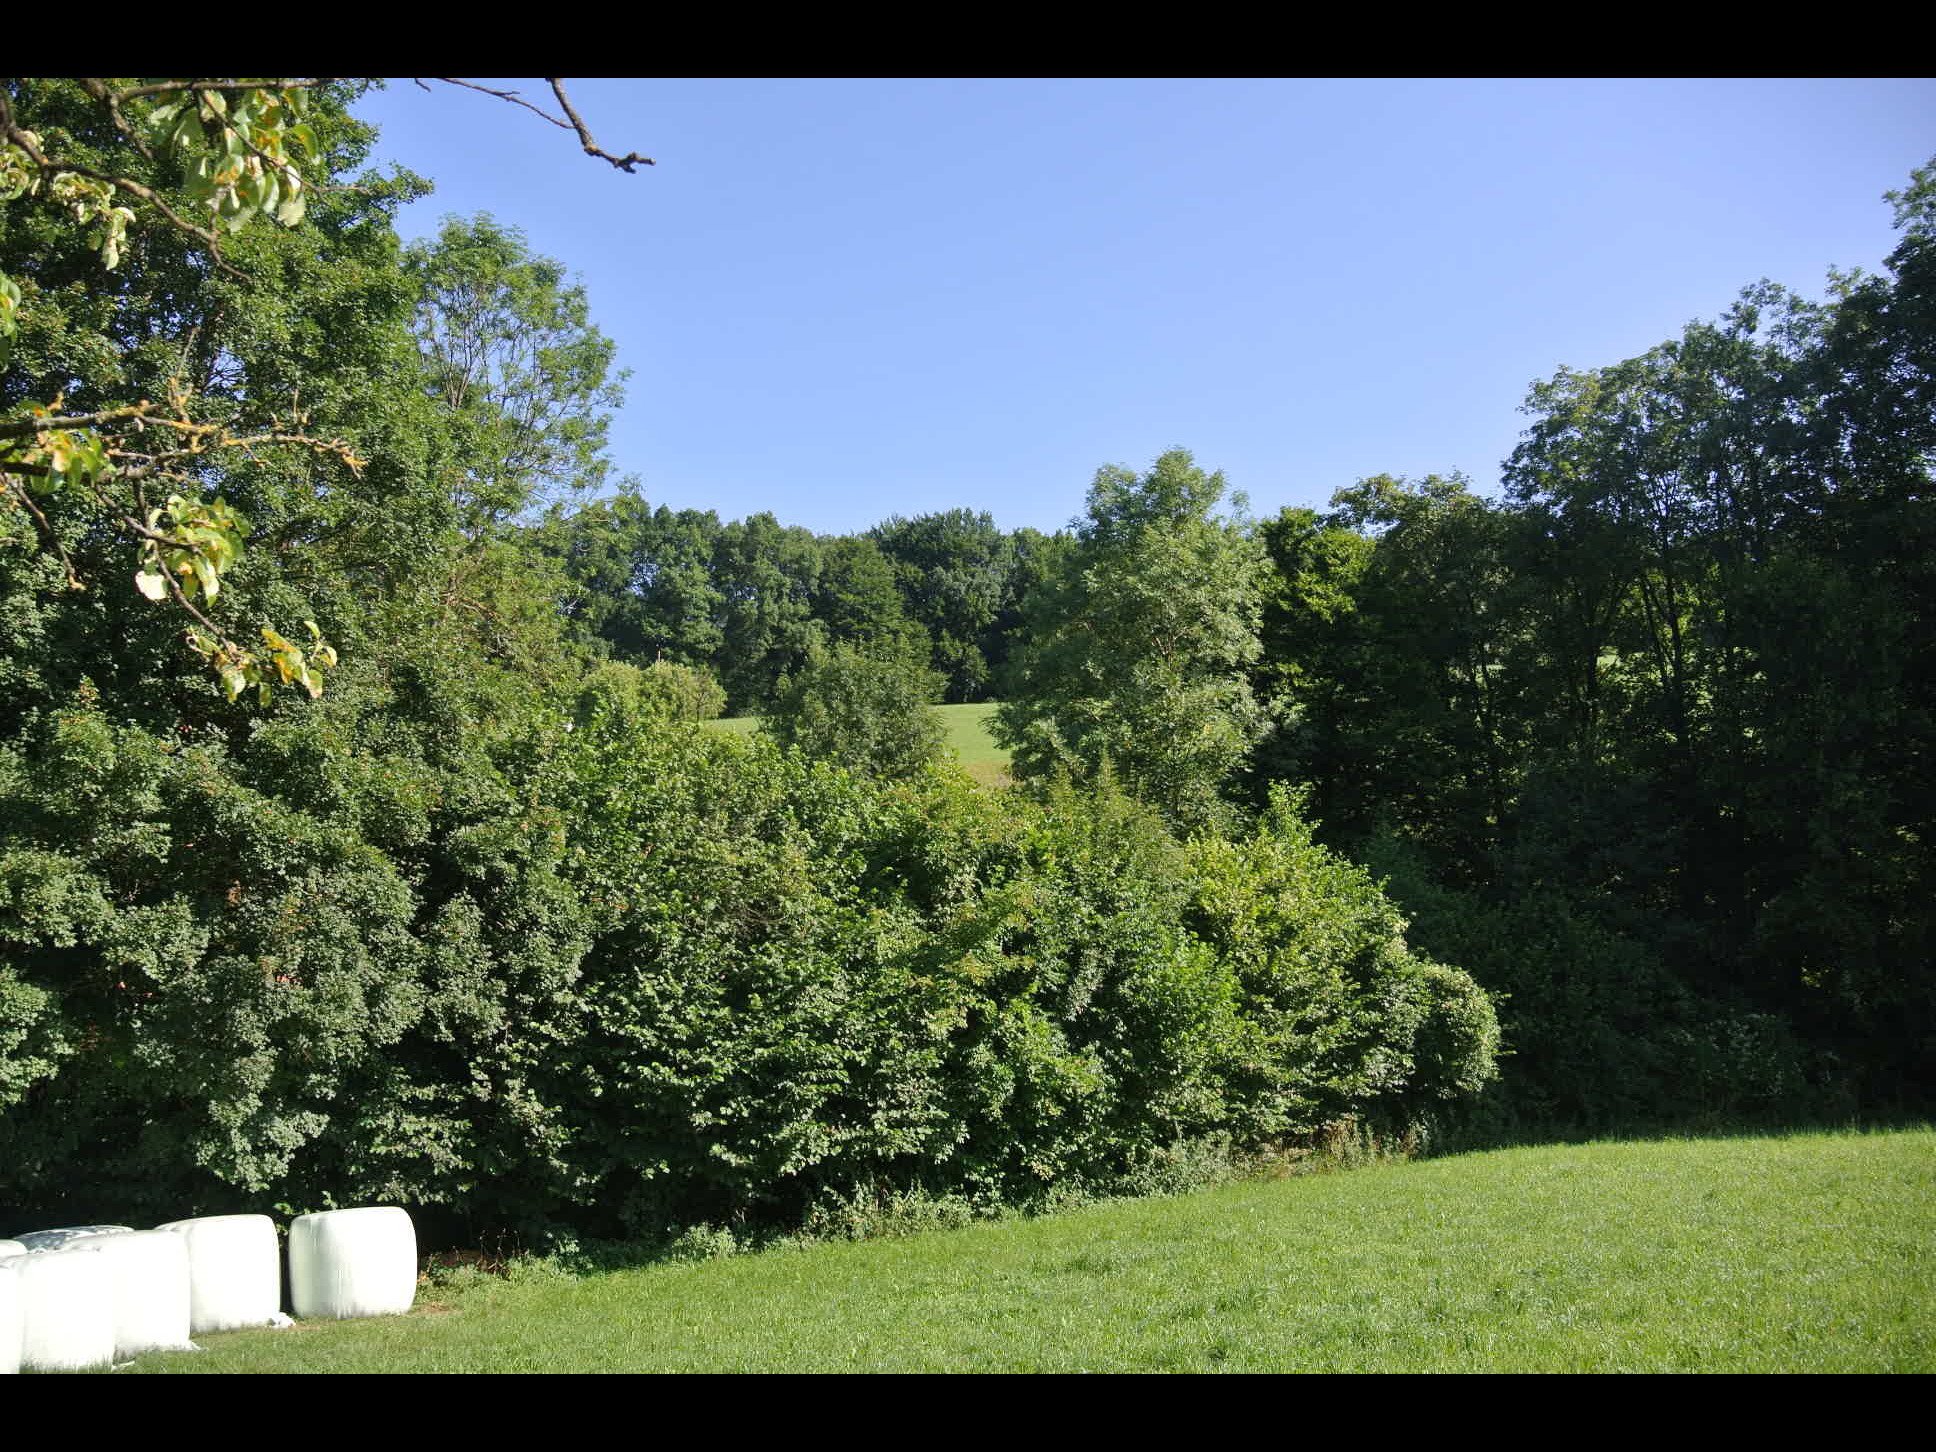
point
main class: Grassland
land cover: Grassland without tree/shrub cover
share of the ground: > 75 %
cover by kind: herbaceous plants 100 %
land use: Agriculture (excluding fallow land and kitchen gardens)
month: July
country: AT
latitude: 48.0895
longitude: 15.7894
